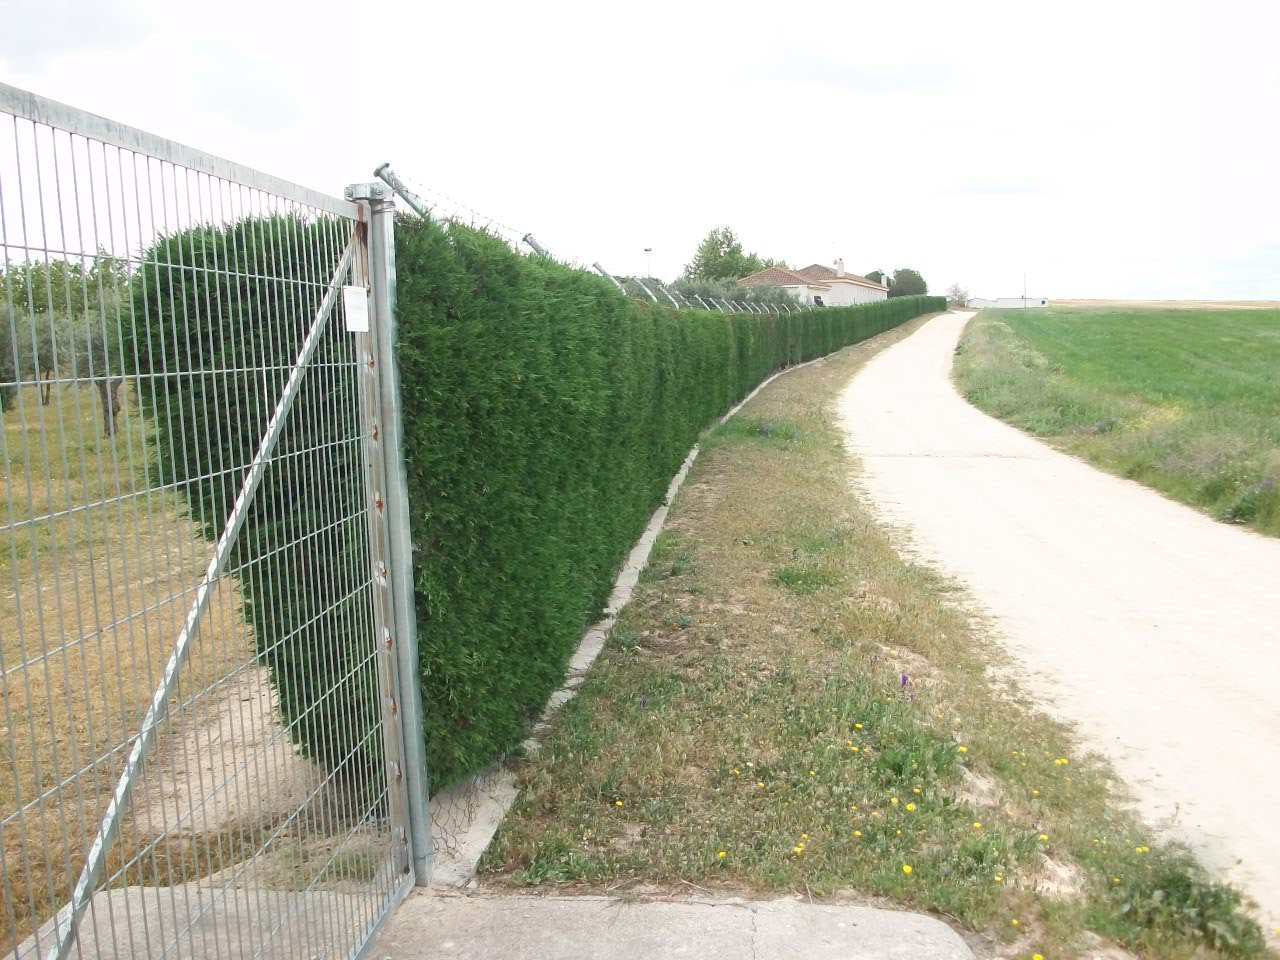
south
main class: Cropland
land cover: Olive groves
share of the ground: 25 - 50 %
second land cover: Grassland without tree/shrub cover
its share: > 75 %
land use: Agriculture (excluding fallow land and kitchen gardens)
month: April
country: ES
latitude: 40.2298
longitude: -3.8703
